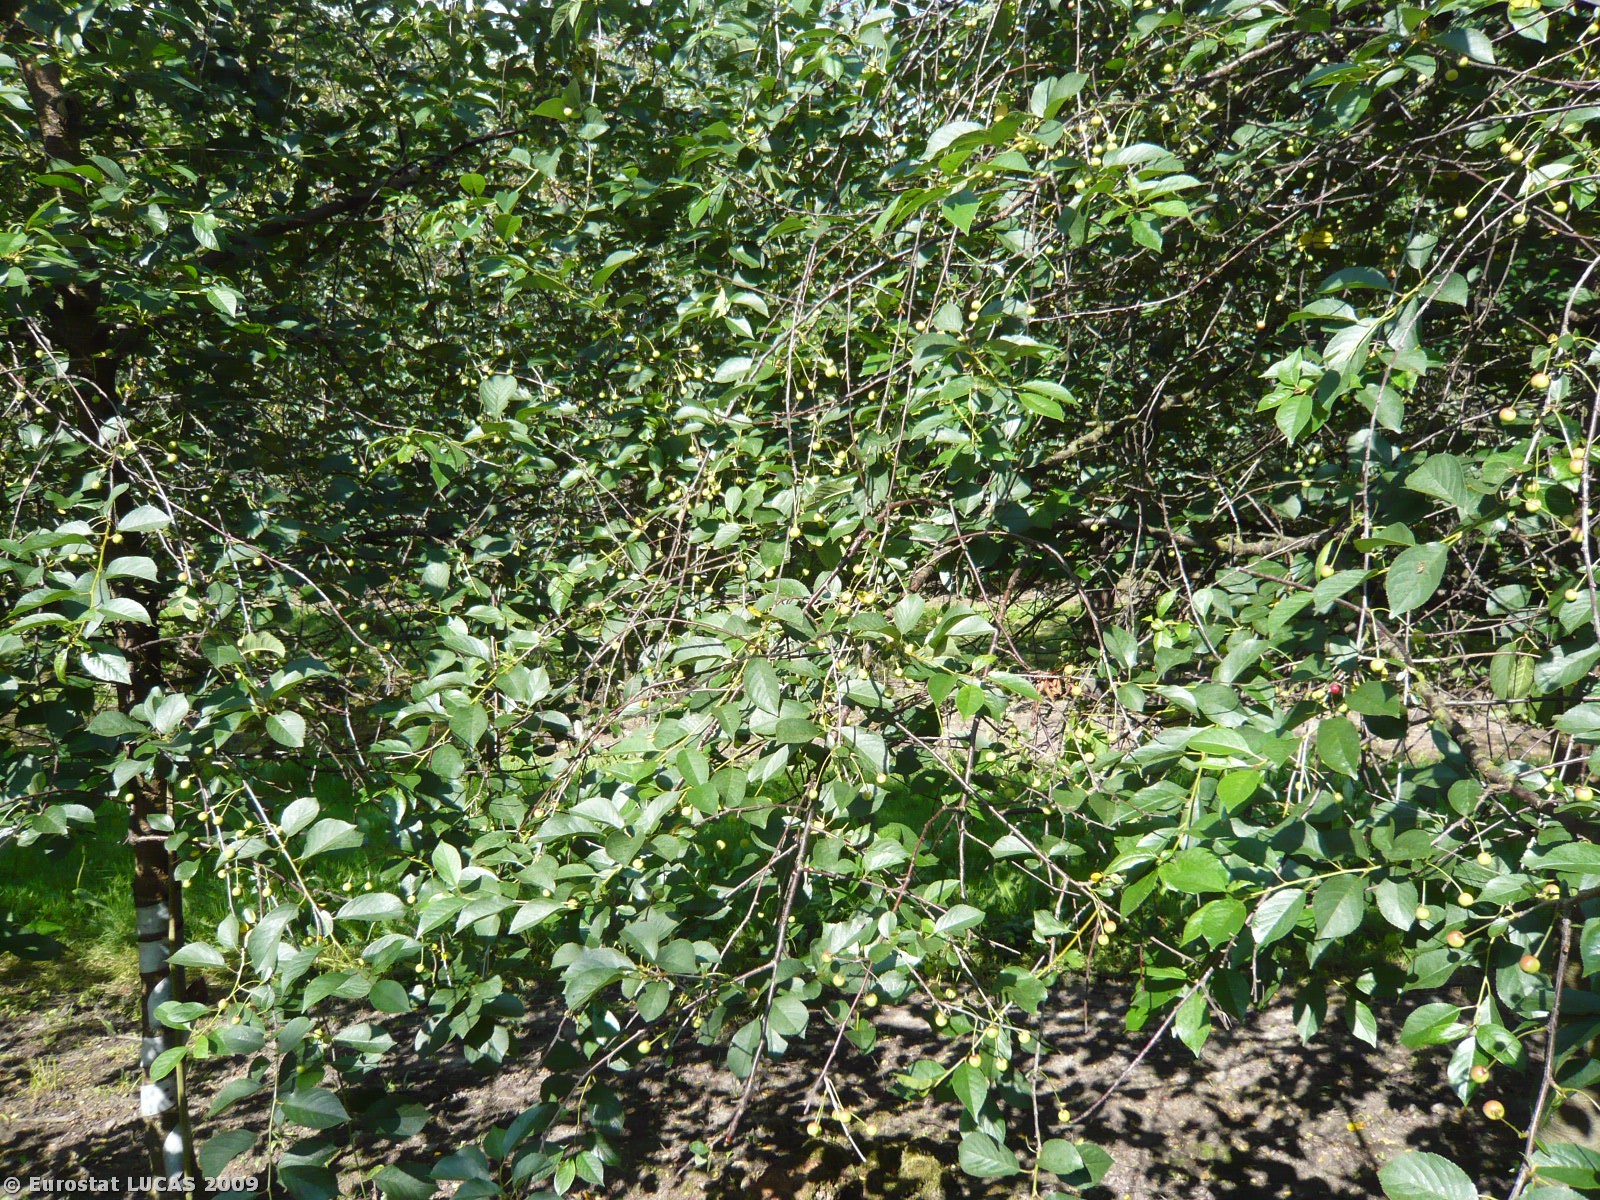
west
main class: Cropland
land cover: Cherry fruit
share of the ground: 50 - 75 %
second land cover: Grassland with sparse tree/shrub cover
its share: 25 - 50 %
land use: Agriculture (excluding fallow land and kitchen gardens)
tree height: < 5 m
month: July
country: DK
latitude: 55.3586
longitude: 10.7722
